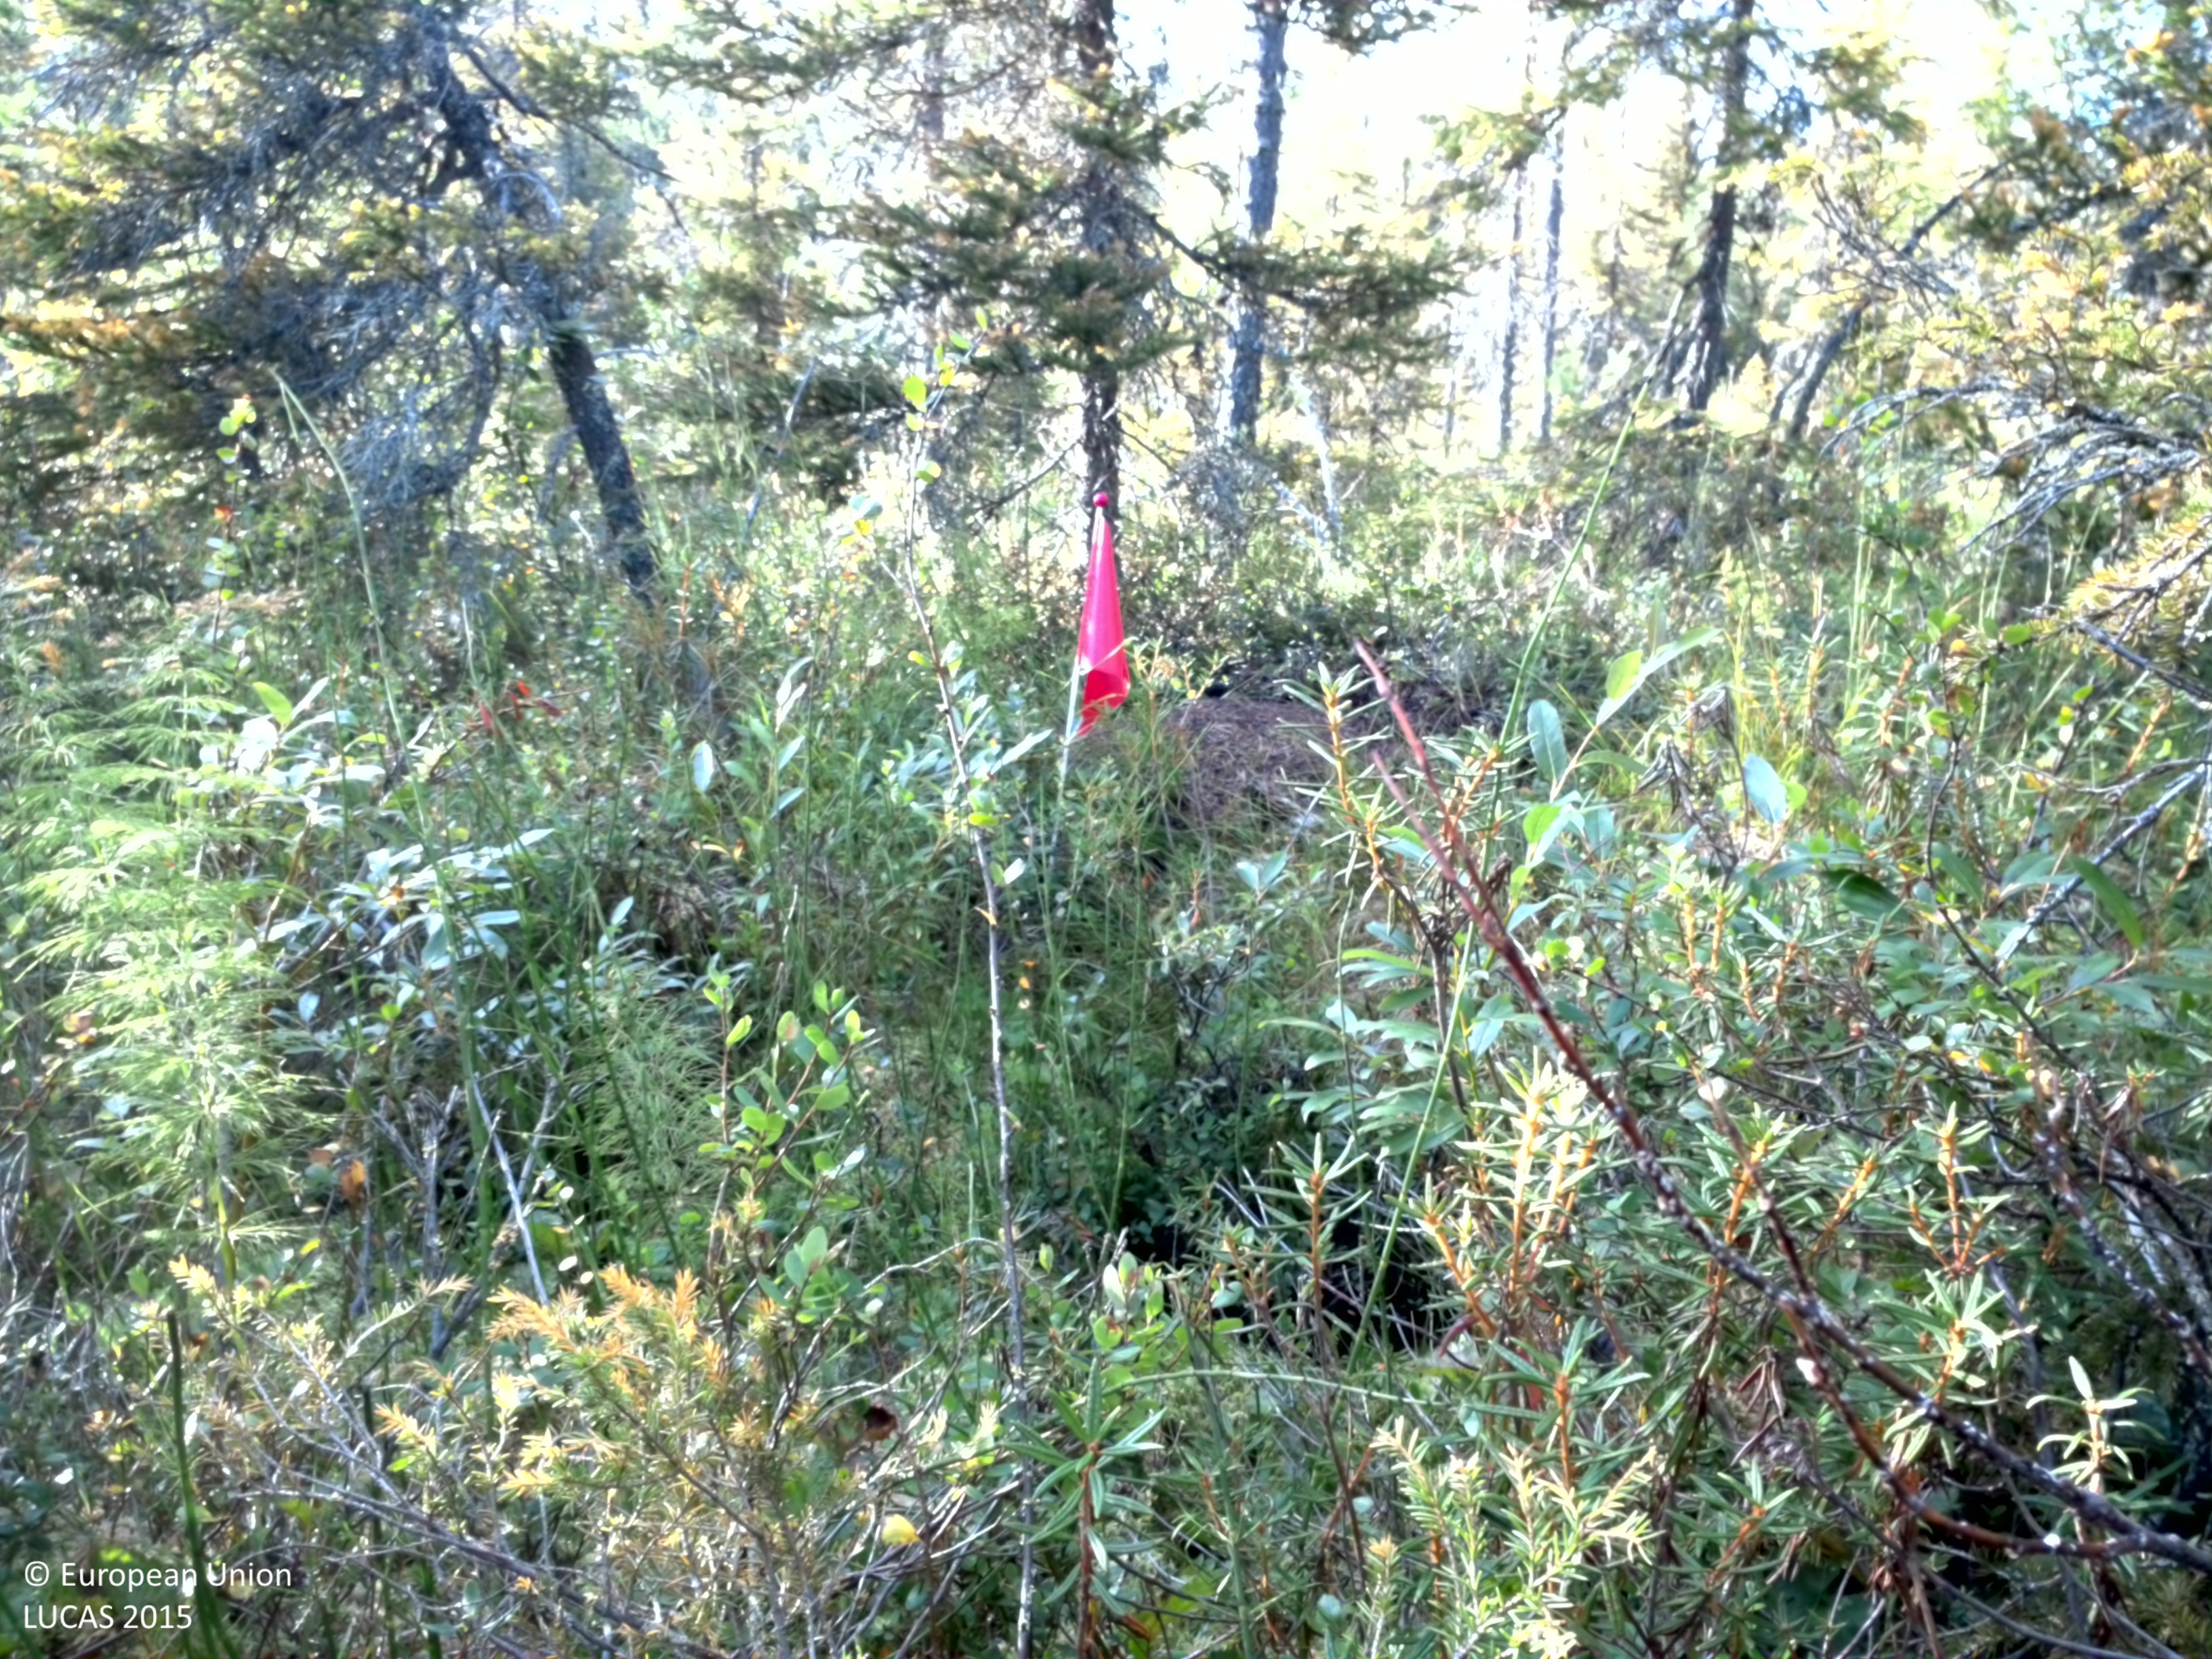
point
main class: Woodland
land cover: Spruce dominated coniferous woodland
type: boreal forest
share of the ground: 25 - 50 %
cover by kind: shrubs 65 %, coniferous forest trees 35 %
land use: Forestry
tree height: > 5 m
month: August
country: SE
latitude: 66.1779
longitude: 22.7367
